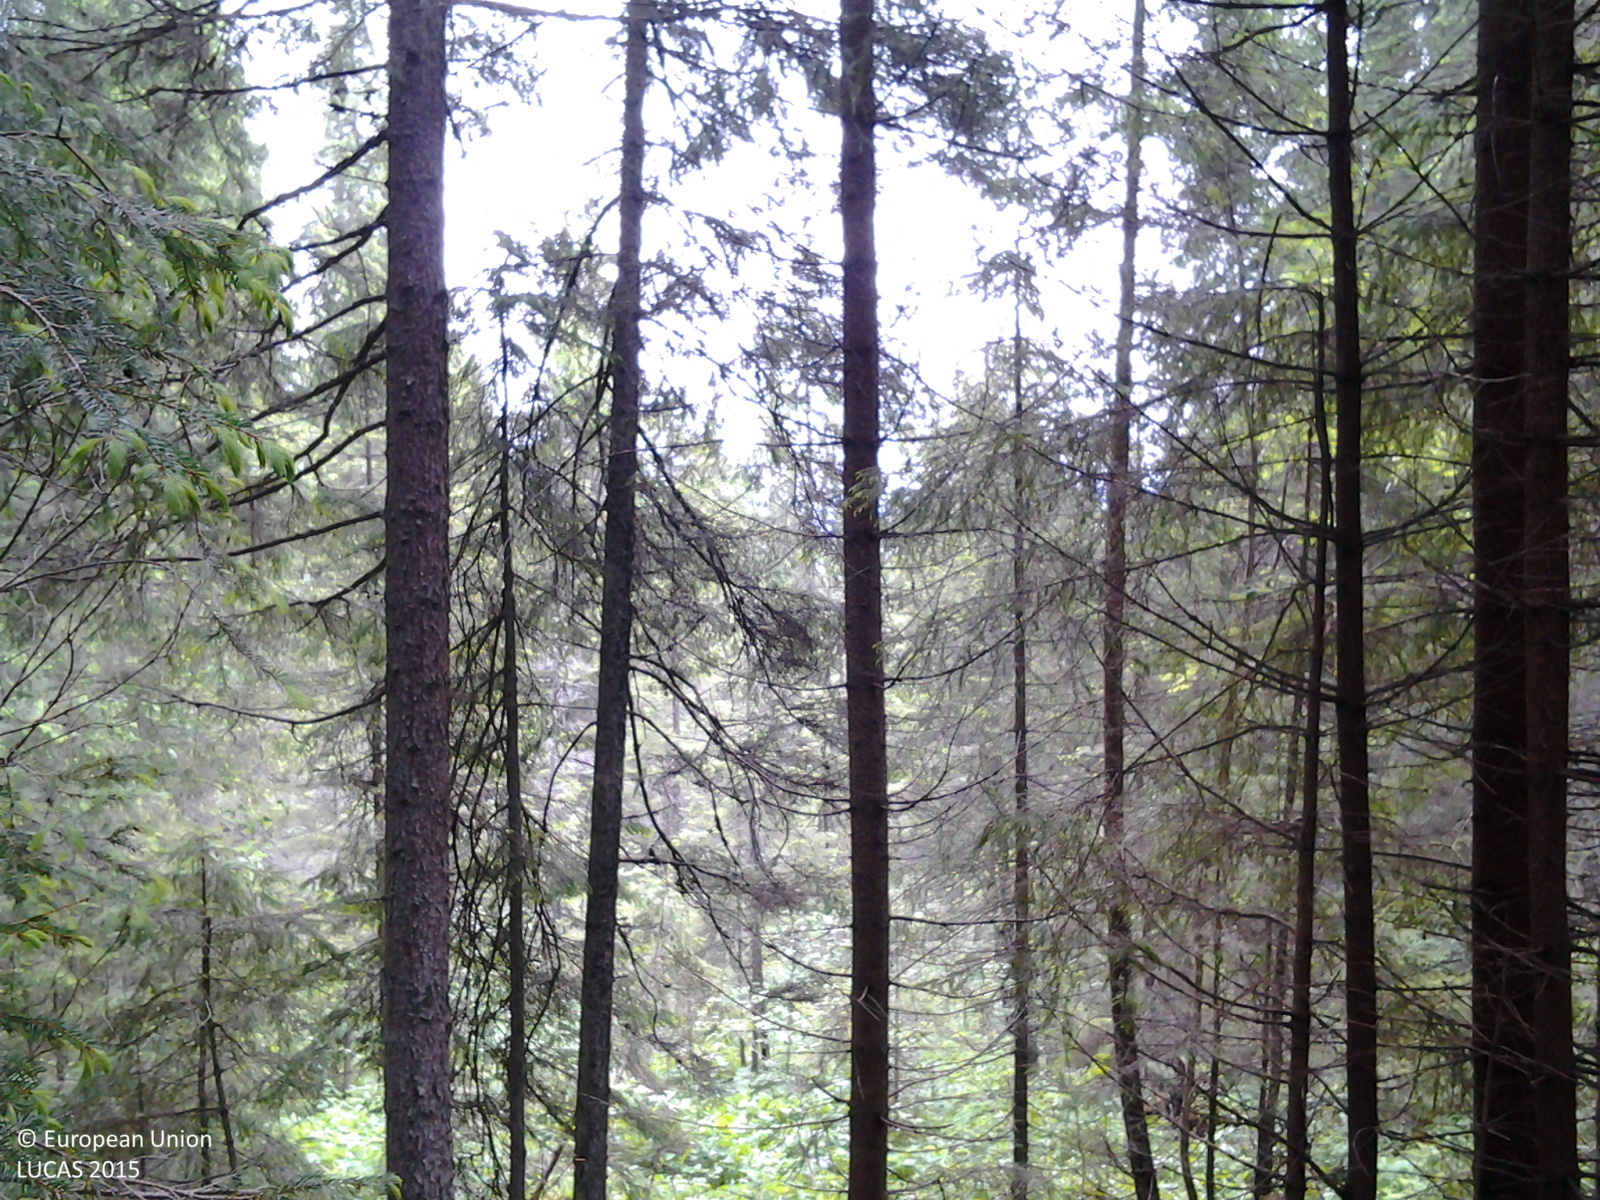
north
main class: Woodland
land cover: Spruce dominated coniferous woodland
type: alpine coniferous forest
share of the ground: > 75 %
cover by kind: coniferous forest trees 100 %
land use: Forestry
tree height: > 5 m
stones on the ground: < 10 %
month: June
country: RO
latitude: 47.7026
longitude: 25.1275
